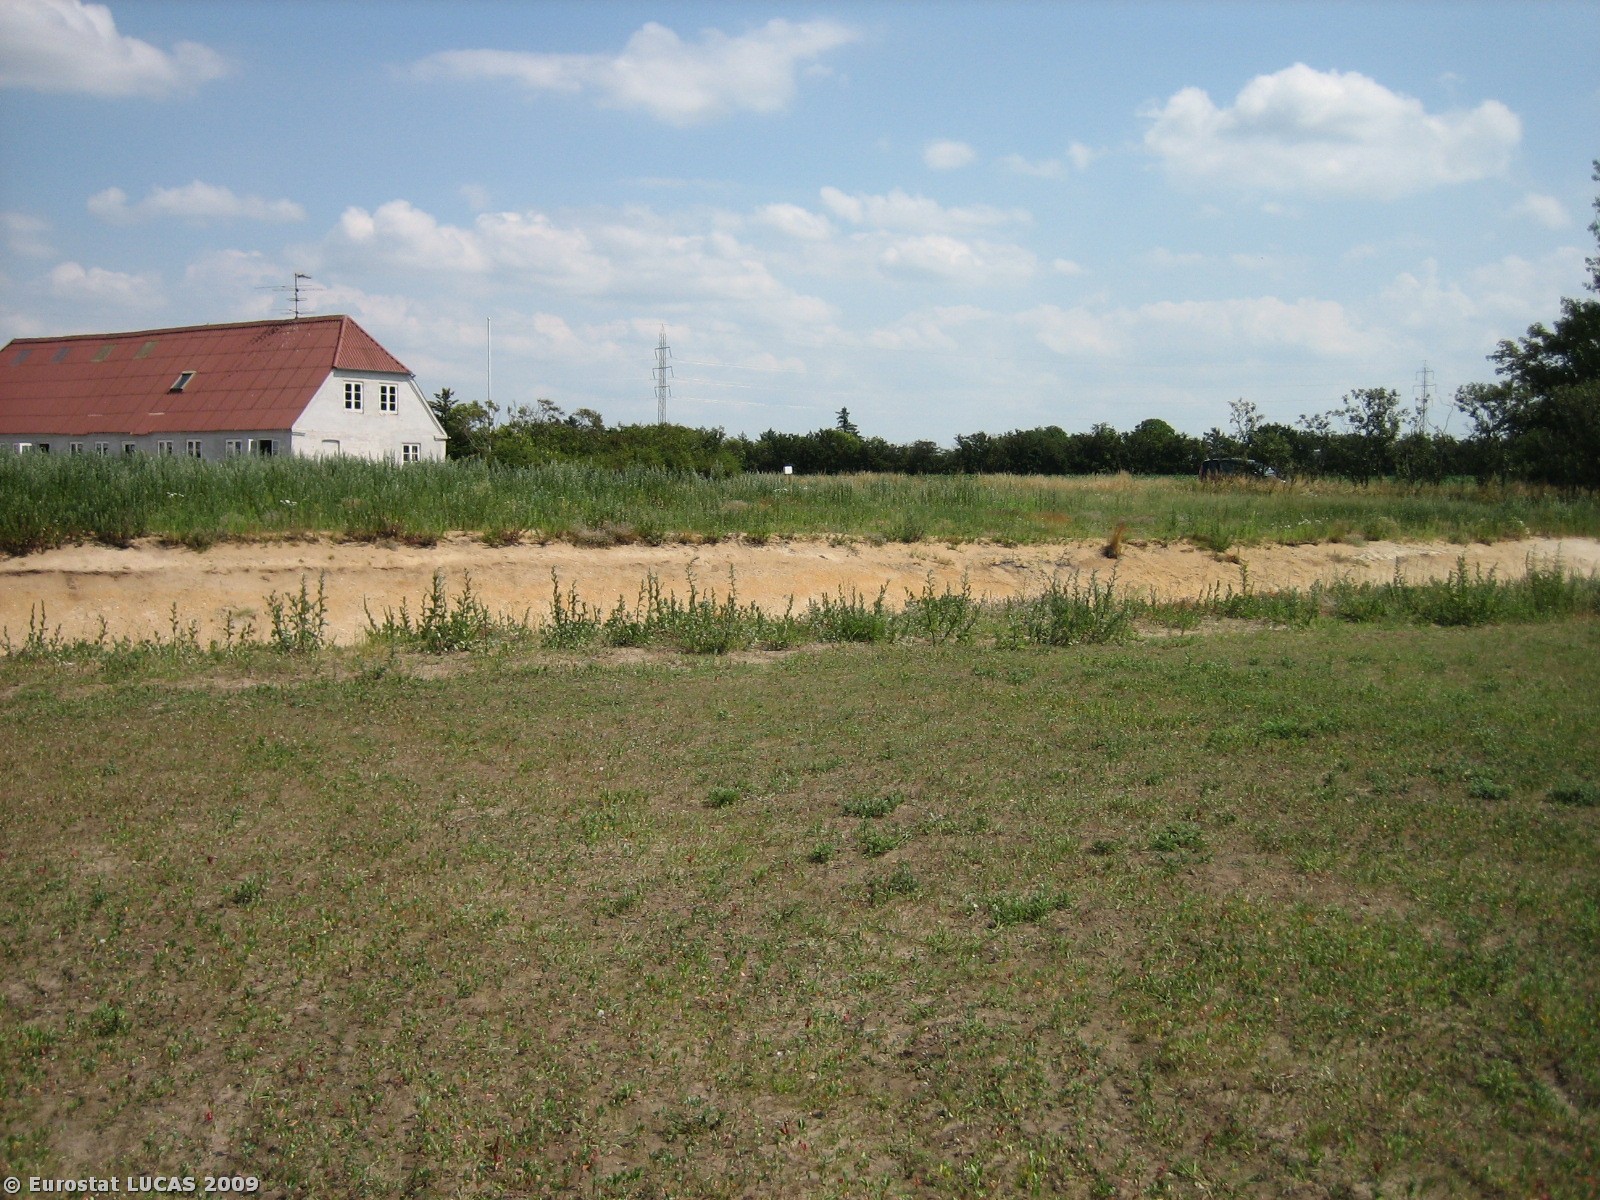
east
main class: Cropland
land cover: Other leguminous and mixtures for fodder
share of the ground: 25 - 50 %
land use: Agriculture (excluding fallow land and kitchen gardens)
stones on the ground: < 10 %
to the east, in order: Other leguminous and mixtures for fodder; Spontaneously vegetated surfaces; Bare land; Spontaneously vegetated surfaces; Tracks; Shrubland with sparse tree cover; Grassland with sparse tree/shrub cover; Shrubland with sparse tree cover; Tracks; Paved roads, cycling and walking lanes; Grass margins; Maize; Broadleaved woodland; Maize
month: July
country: DK
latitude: 55.3551
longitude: 8.7866
